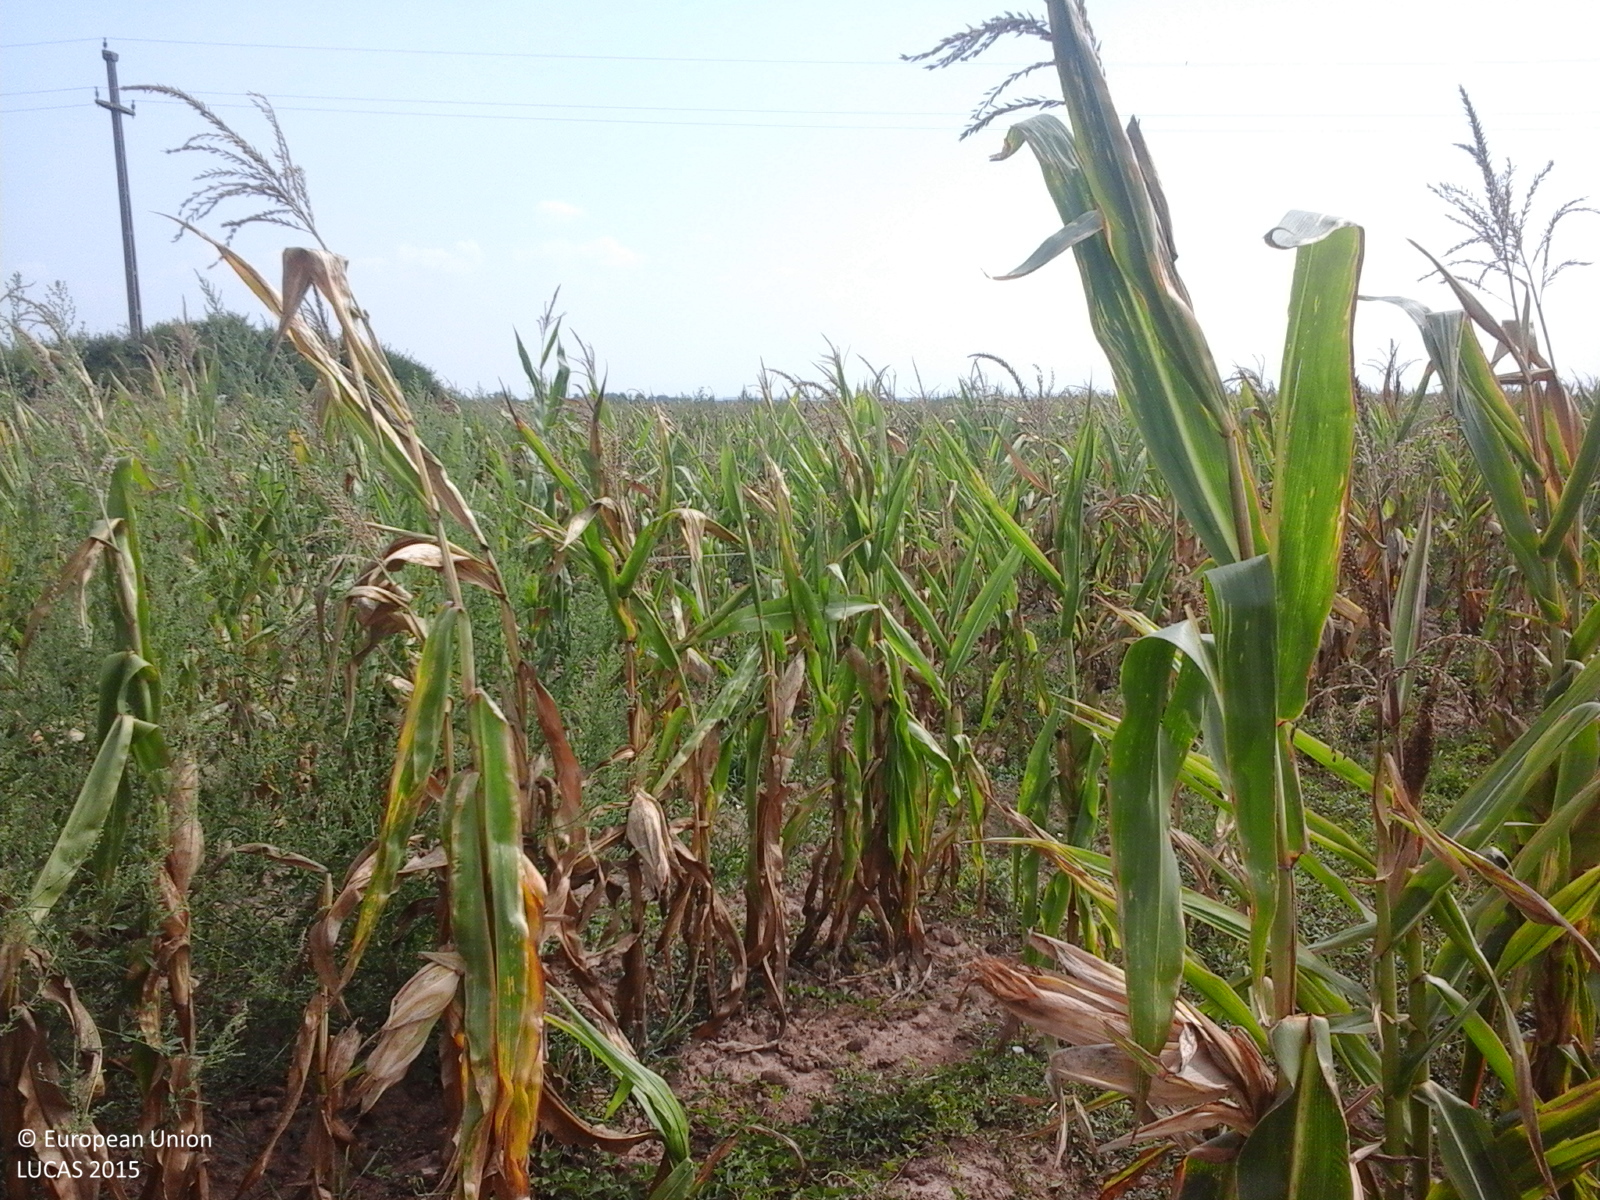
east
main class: Cropland
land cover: Maize
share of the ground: > 75 %
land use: Agriculture (excluding fallow land and kitchen gardens)
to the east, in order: Maize; Lucerne; Sunflower; Common wheat; Spontaneously vegetated surfaces; Common wheat
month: August
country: RO
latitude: 46.5954
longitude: 21.7236
